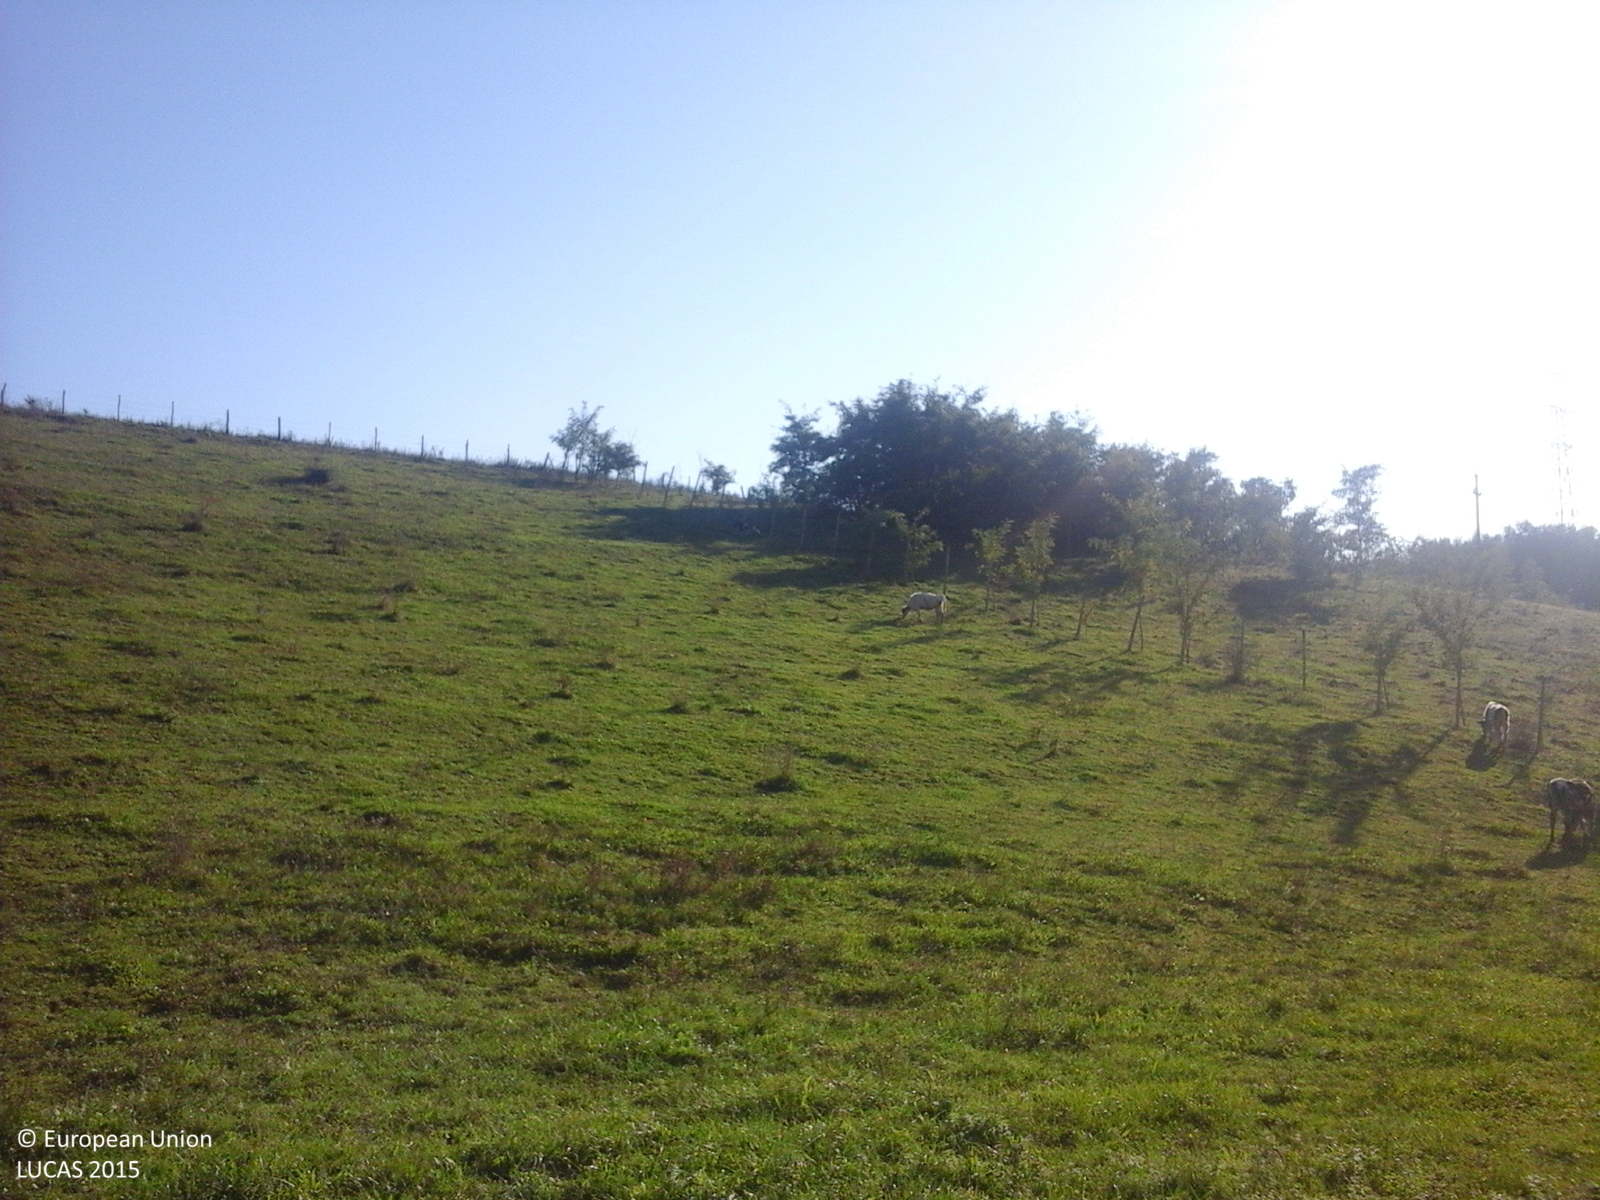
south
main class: Grassland
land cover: Grassland without tree/shrub cover
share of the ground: > 75 %
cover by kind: herbaceous plants 100 %
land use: Agriculture (excluding fallow land and kitchen gardens)
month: October
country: RO
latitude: 46.3665
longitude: 23.7854
